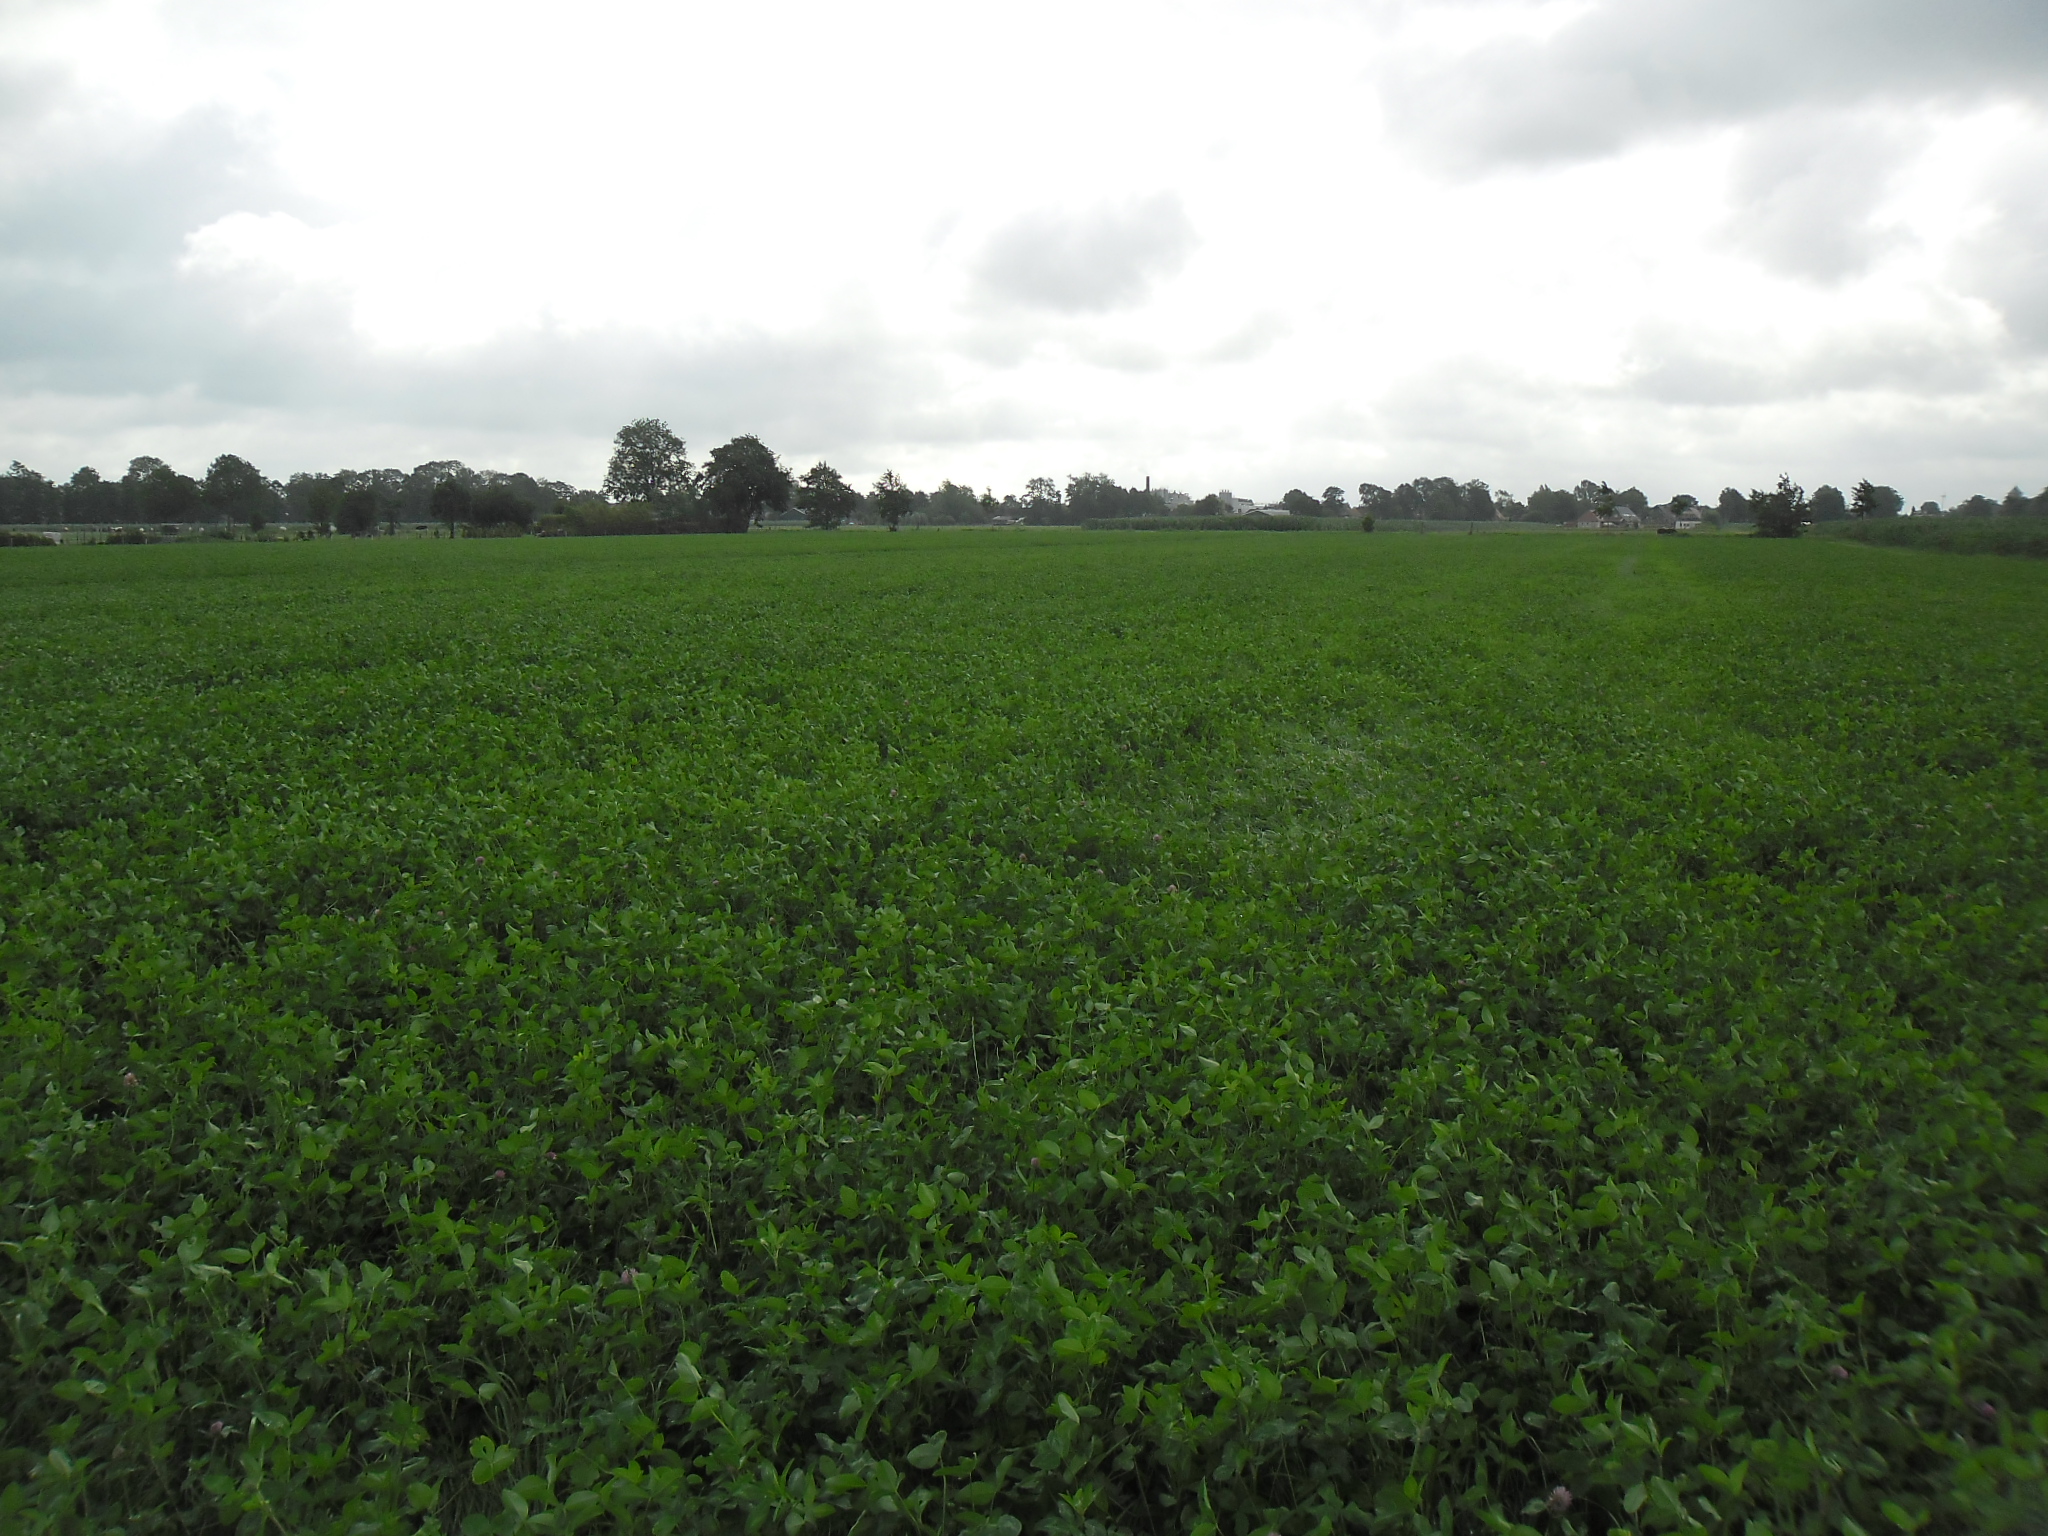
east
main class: Cropland
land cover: Other leguminous and mixtures for fodder
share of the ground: > 75 %
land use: Agriculture (excluding fallow land and kitchen gardens)
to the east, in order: Other leguminous and mixtures for fodder; Ditches and canals; Other leguminous and mixtures for fodder; Ditches and canals; Grass margins; Paved roads, cycling and walking lanes; Grass margins; Ditches and canals; Electric lines; Single bushes/trees; Grassland without tree/shrub cover
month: July
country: NL
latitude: 52.6218
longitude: 6.1736
